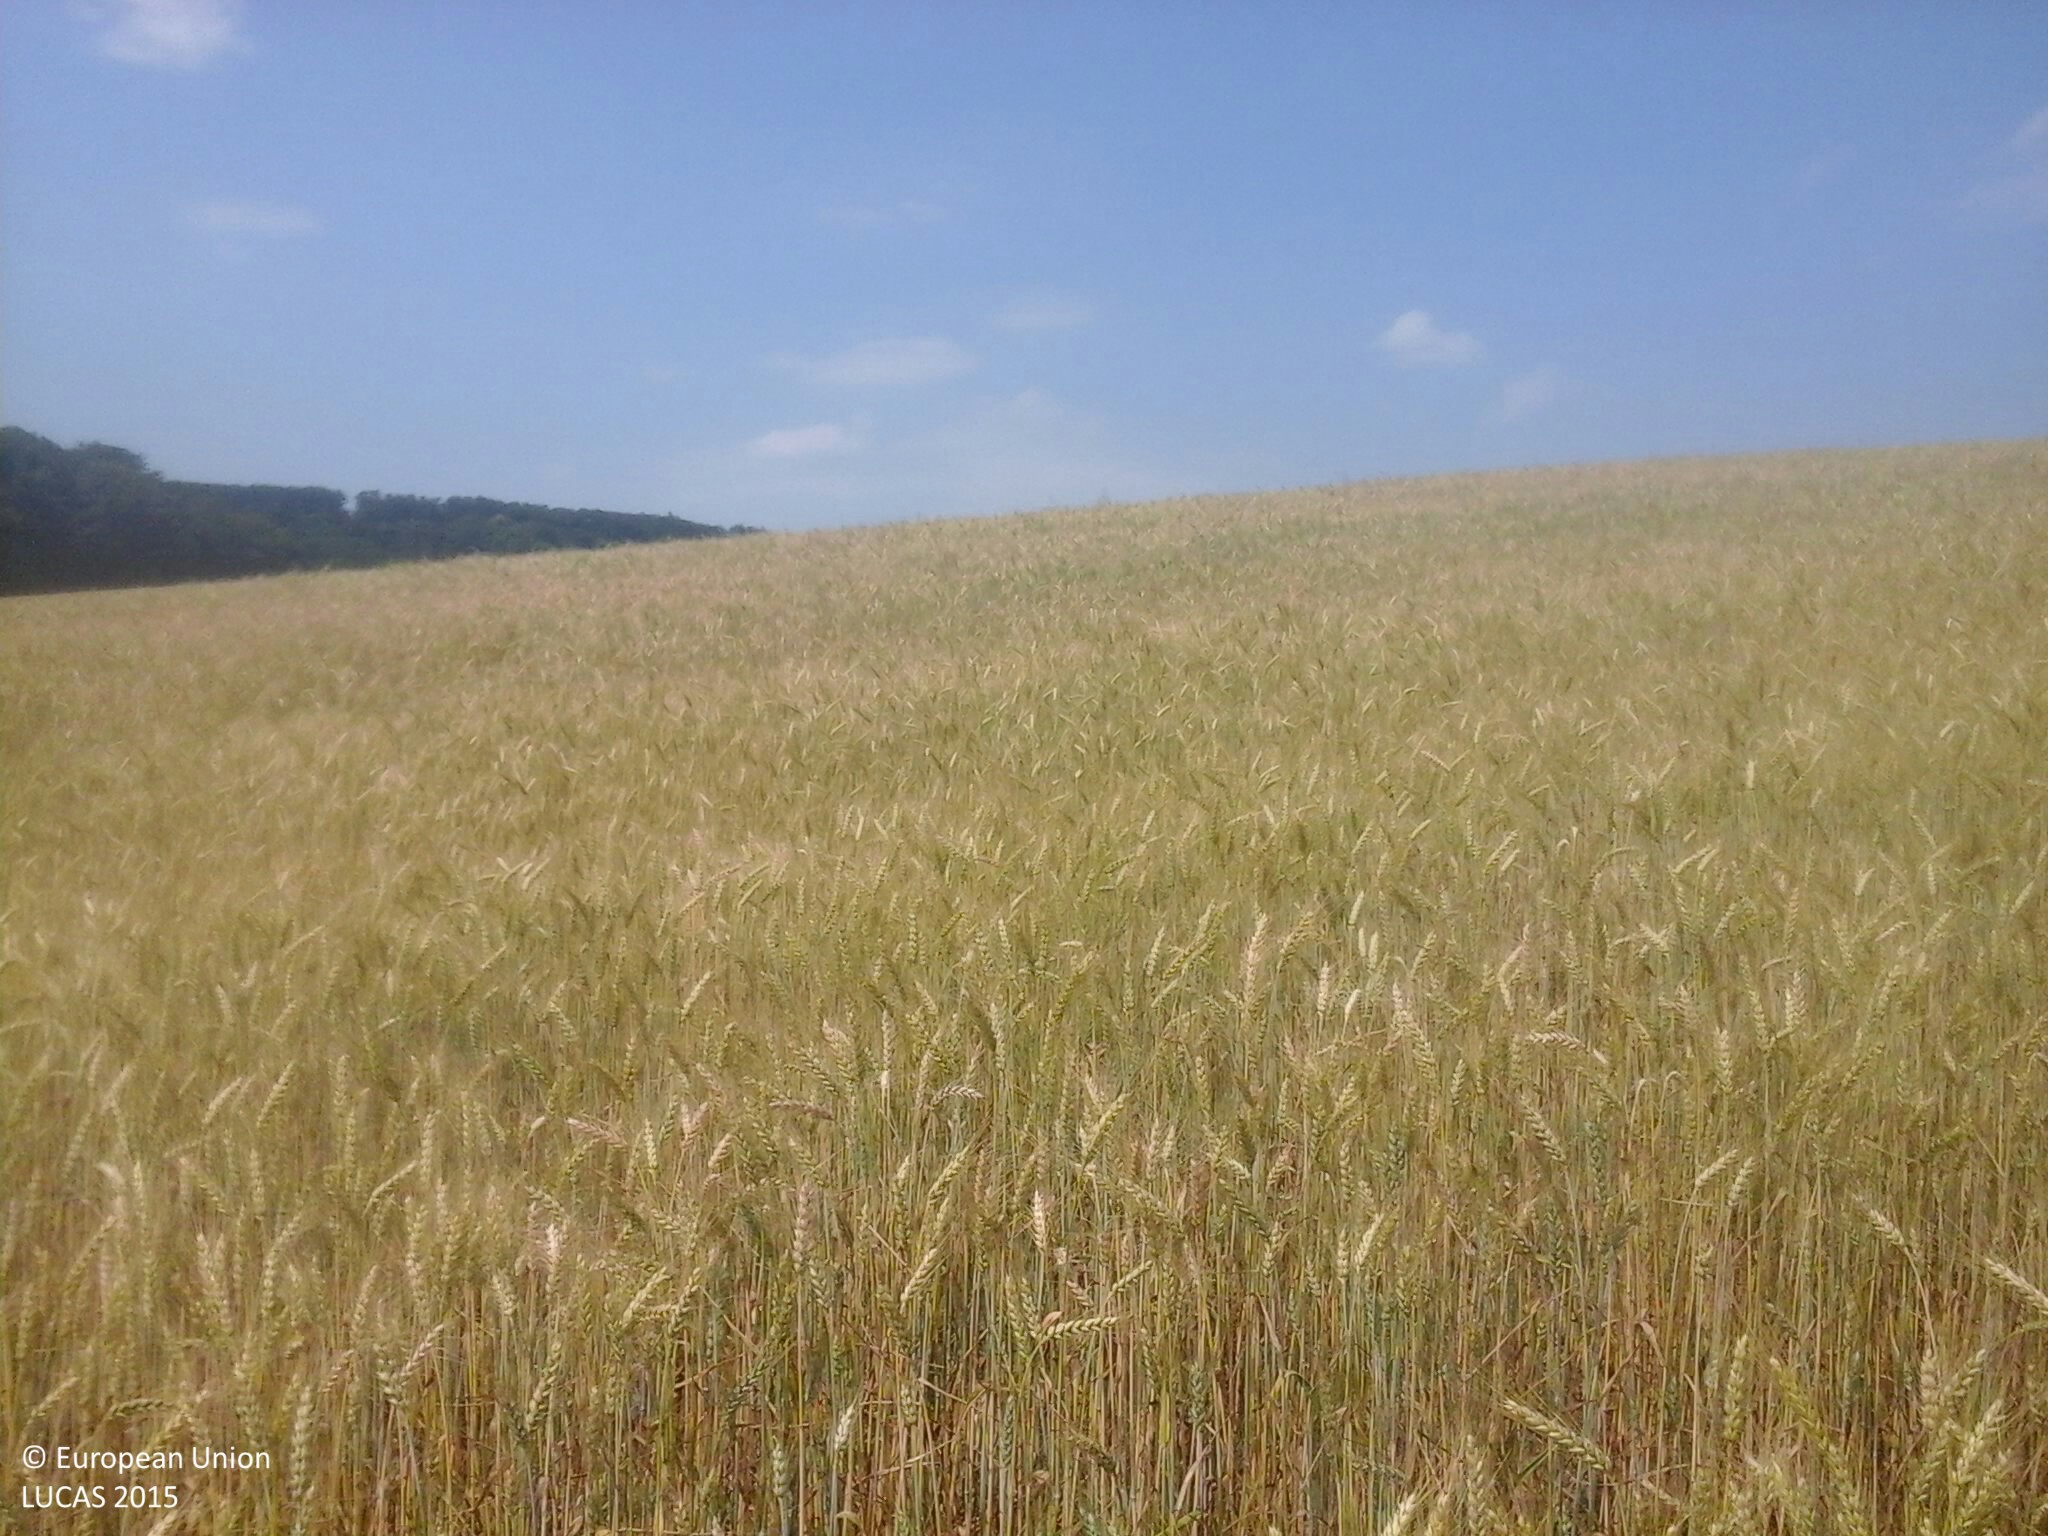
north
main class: Cropland
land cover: Common wheat
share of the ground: > 75 %
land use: Agriculture (excluding fallow land and kitchen gardens)
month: July
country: HU
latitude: 47.3141
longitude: 17.8008
